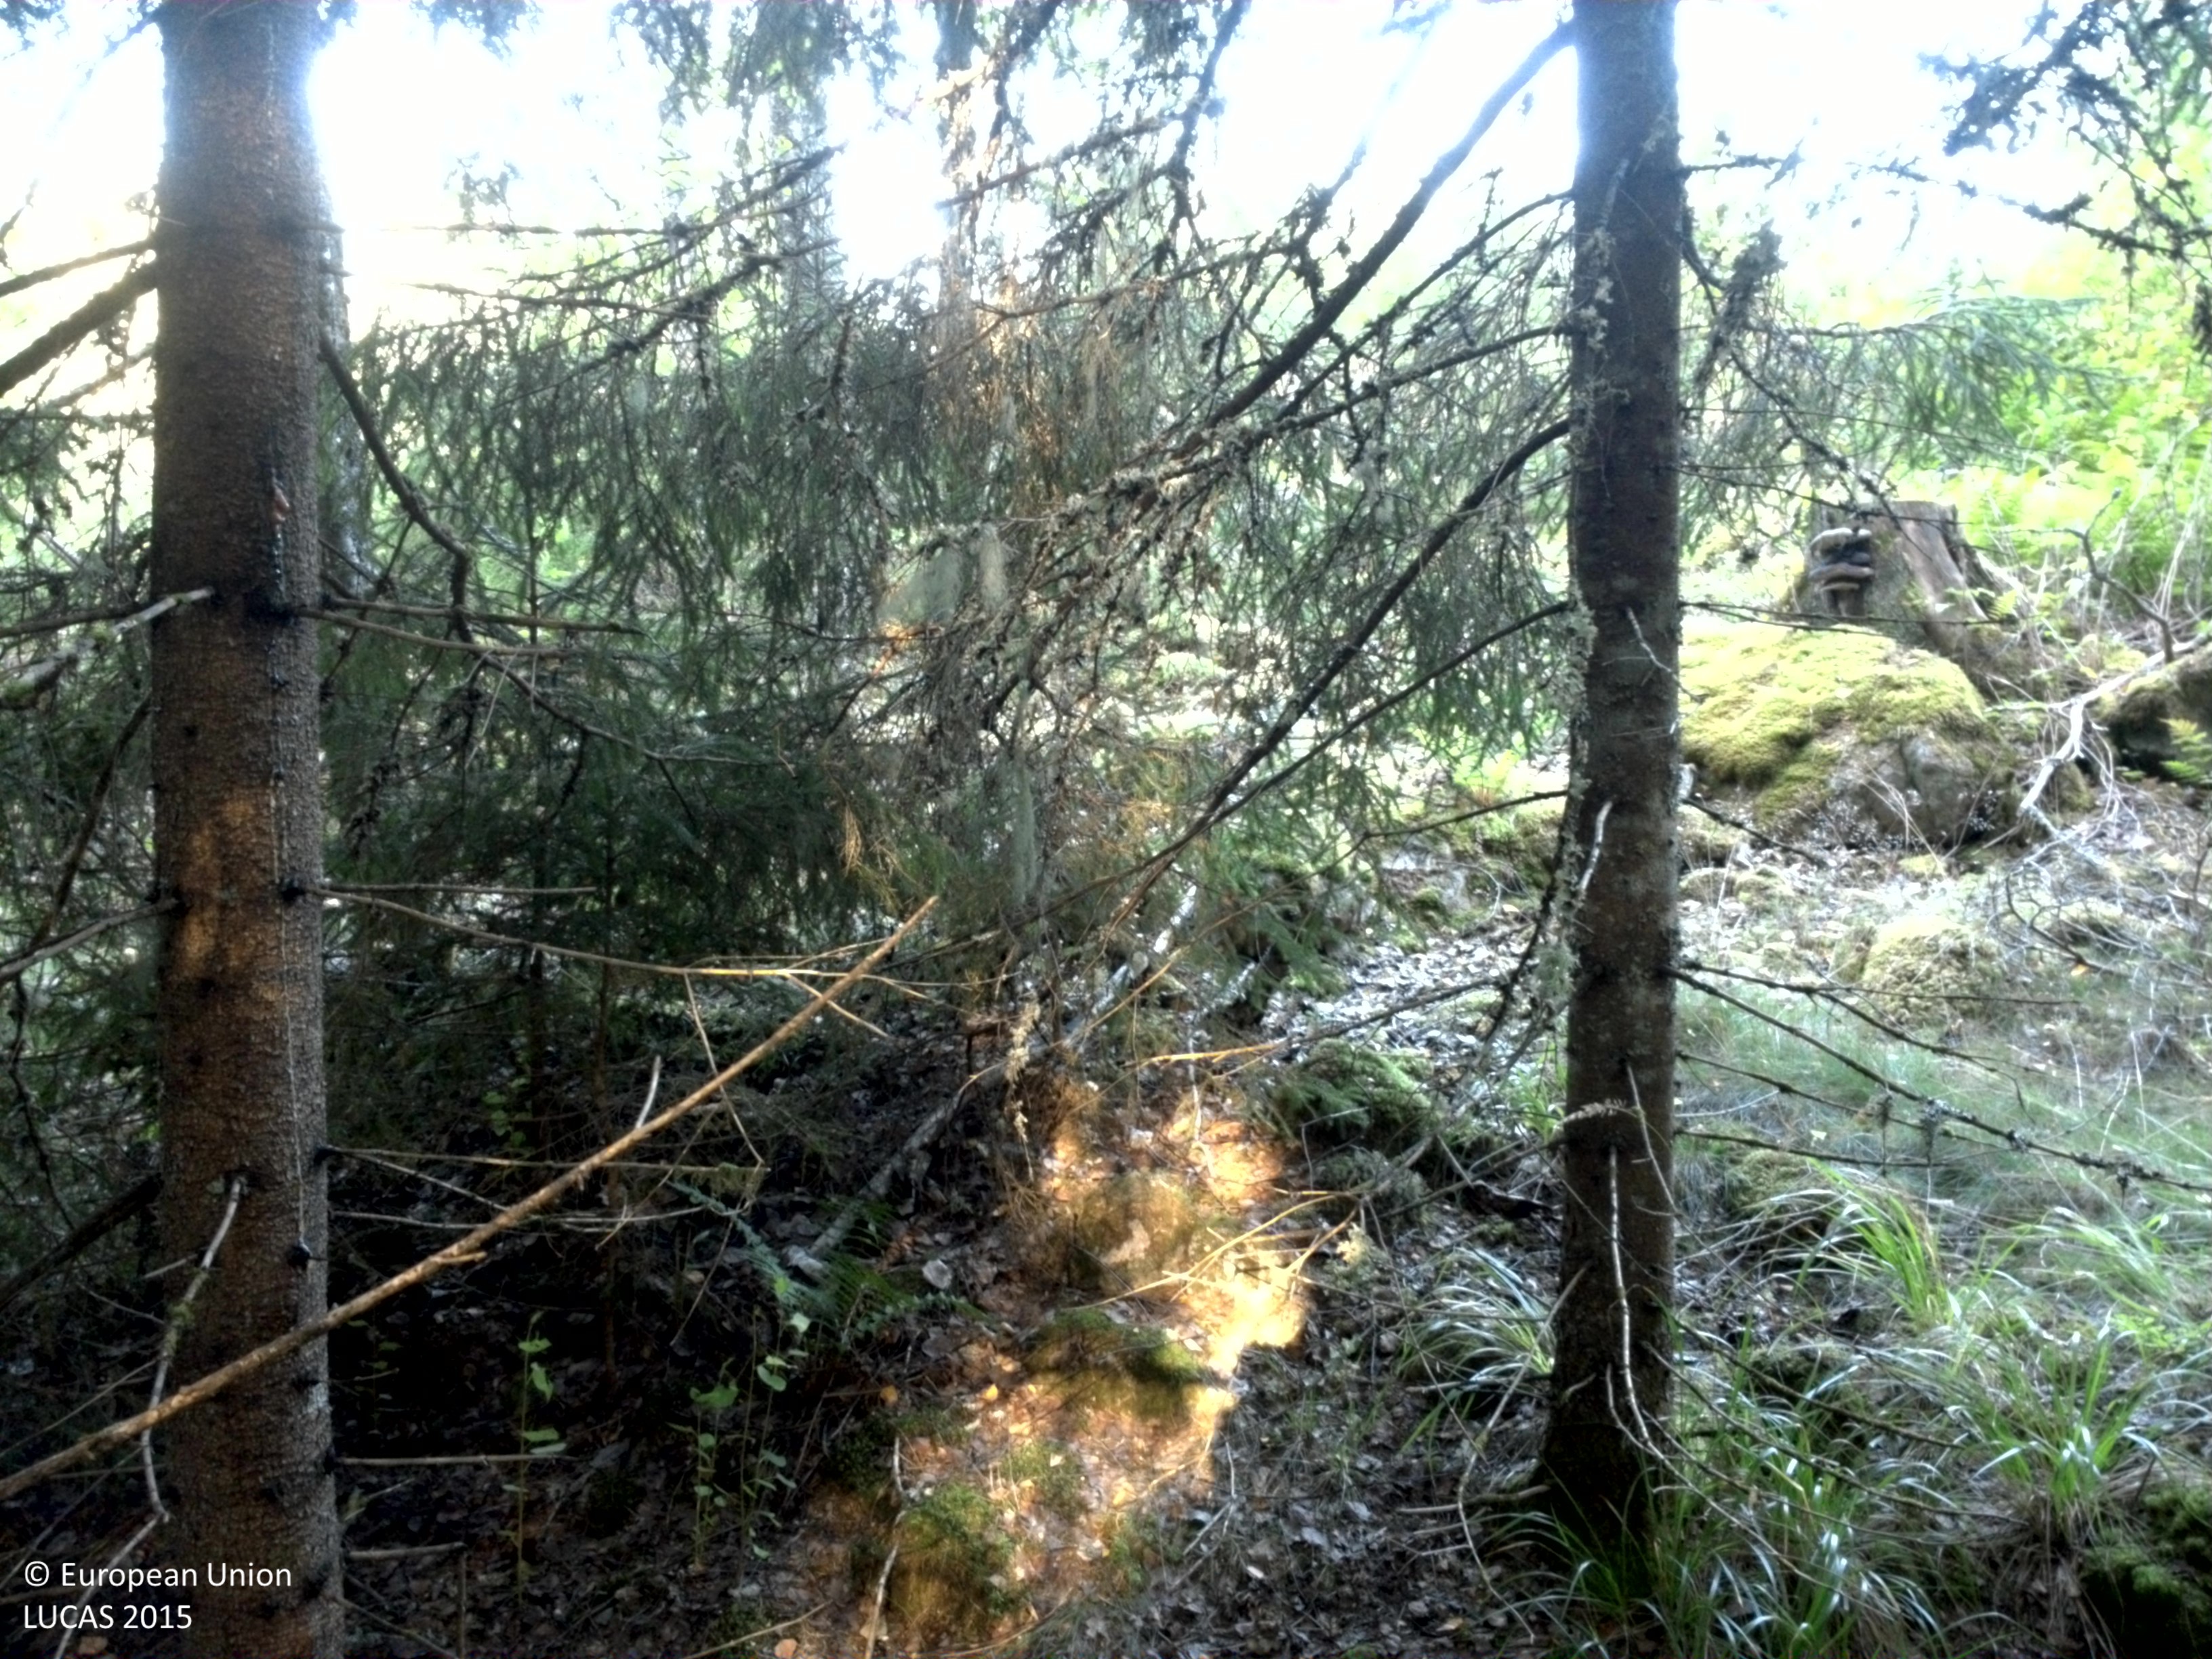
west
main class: Woodland
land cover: Spruce dominated mixed woodland
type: boreal forest
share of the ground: 50 - 75 %
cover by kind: coniferous forest trees 40 %, broadleaved forest trees 30 %, shrubs 15 %, herbaceous plants 15 %
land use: Forestry
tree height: > 5 m
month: August
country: SE
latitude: 59.8437
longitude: 15.8259
